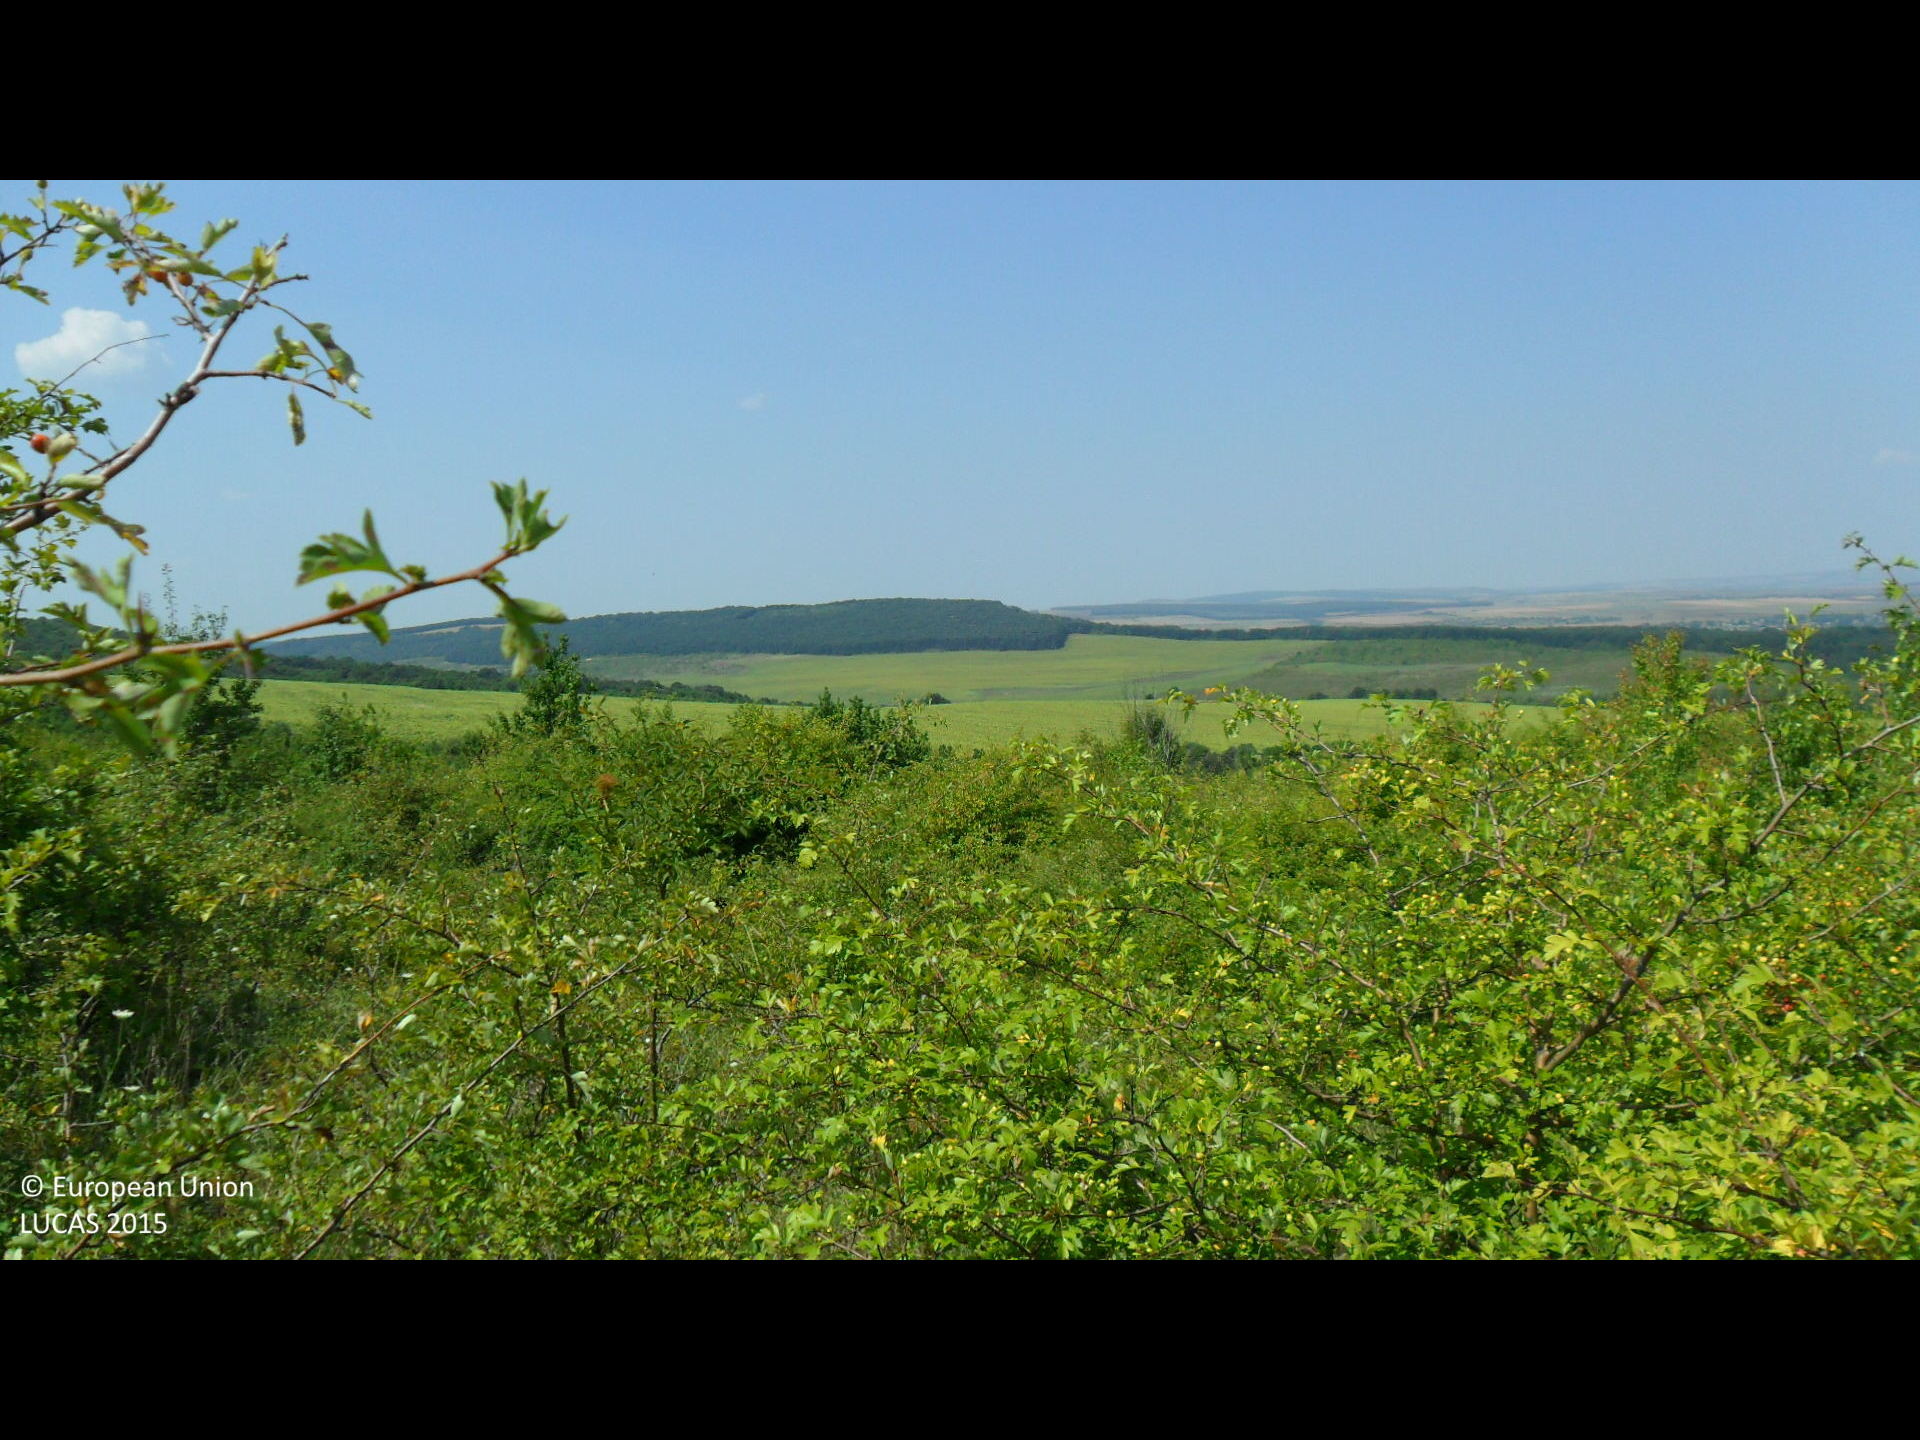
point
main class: Shrubland
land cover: Shrubland with sparse tree cover
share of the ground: > 75 %
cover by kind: shrubs 90 %, broadleaved forest trees 5 %, herbaceous plants 5 %
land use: Semi-natural and natural areas not in use
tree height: < 5 m
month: August
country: BG
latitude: 43.2854
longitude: 26.3285
